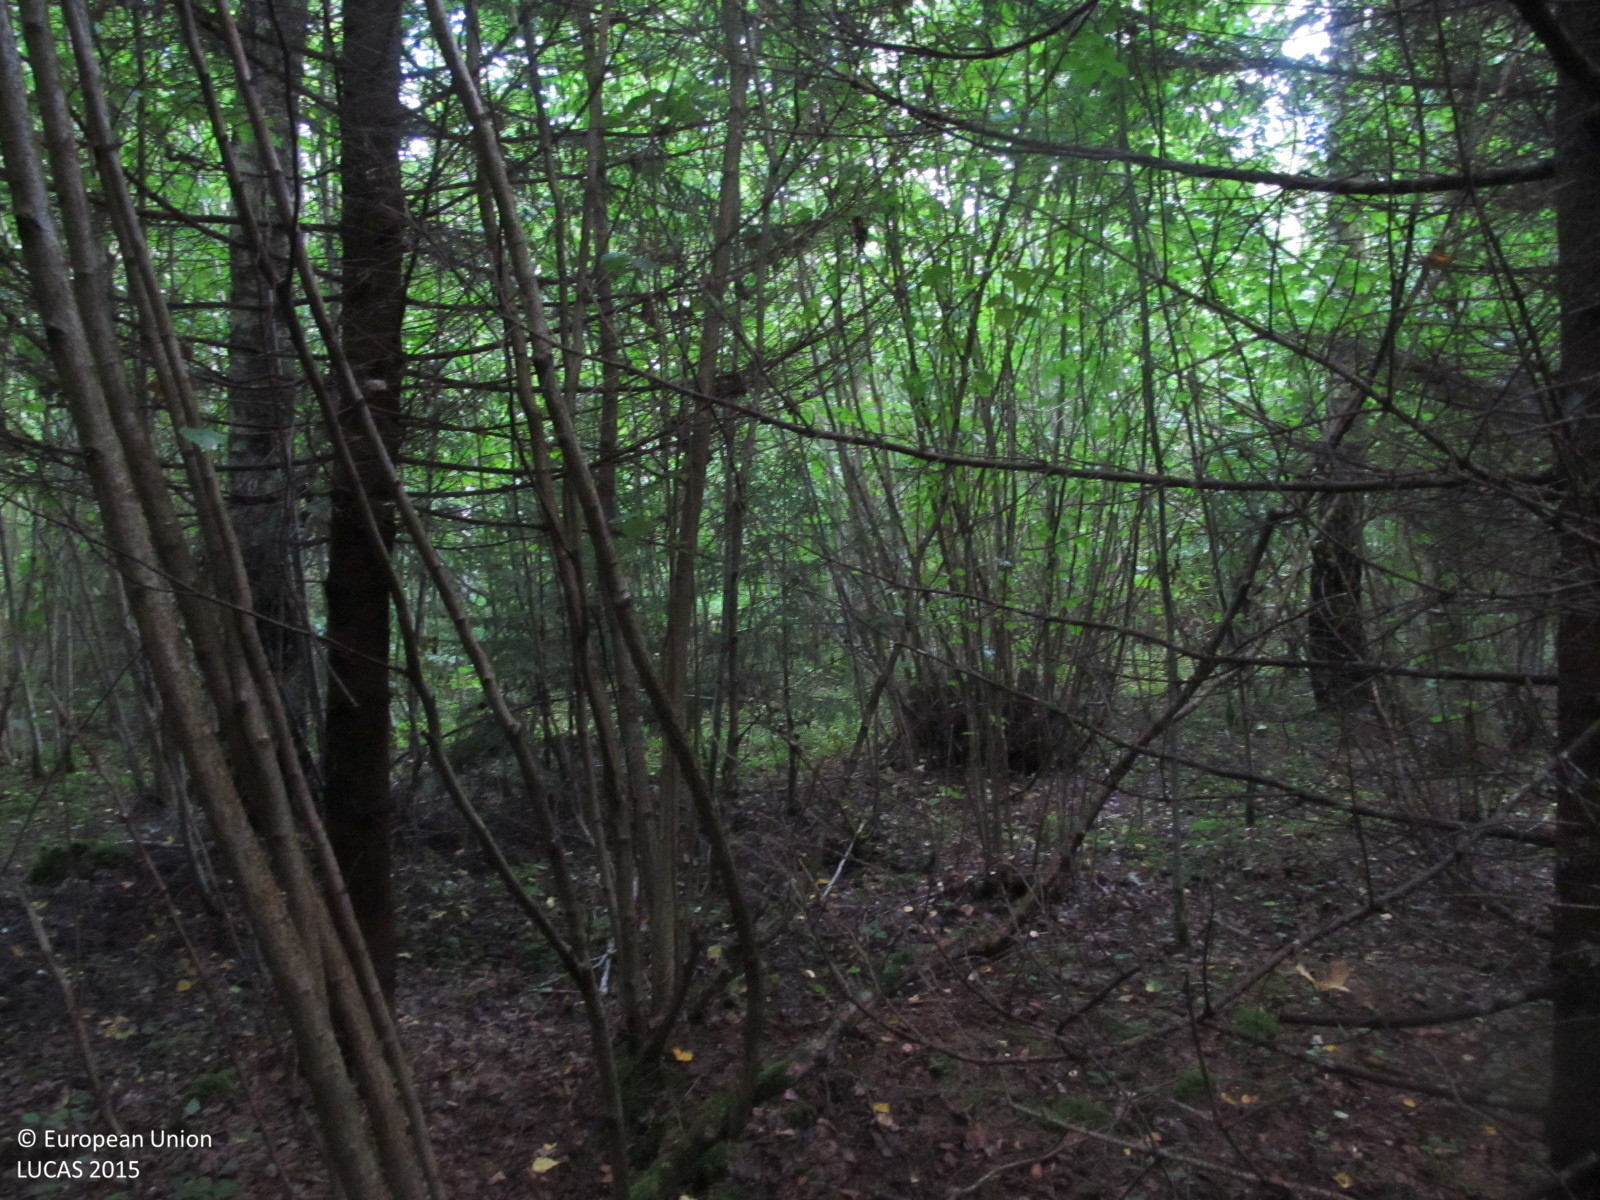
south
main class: Woodland
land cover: Spruce dominated mixed woodland
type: hemiboreal forest and nemoral coniferous forest and mixed broadleaved-coniferous forest
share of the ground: > 75 %
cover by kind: coniferous forest trees 55 %, broadleaved forest trees 40 %, lichens and mosses 5 %
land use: Forestry
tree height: > 5 m
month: September
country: LT
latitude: 56.2189
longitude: 23.1479
